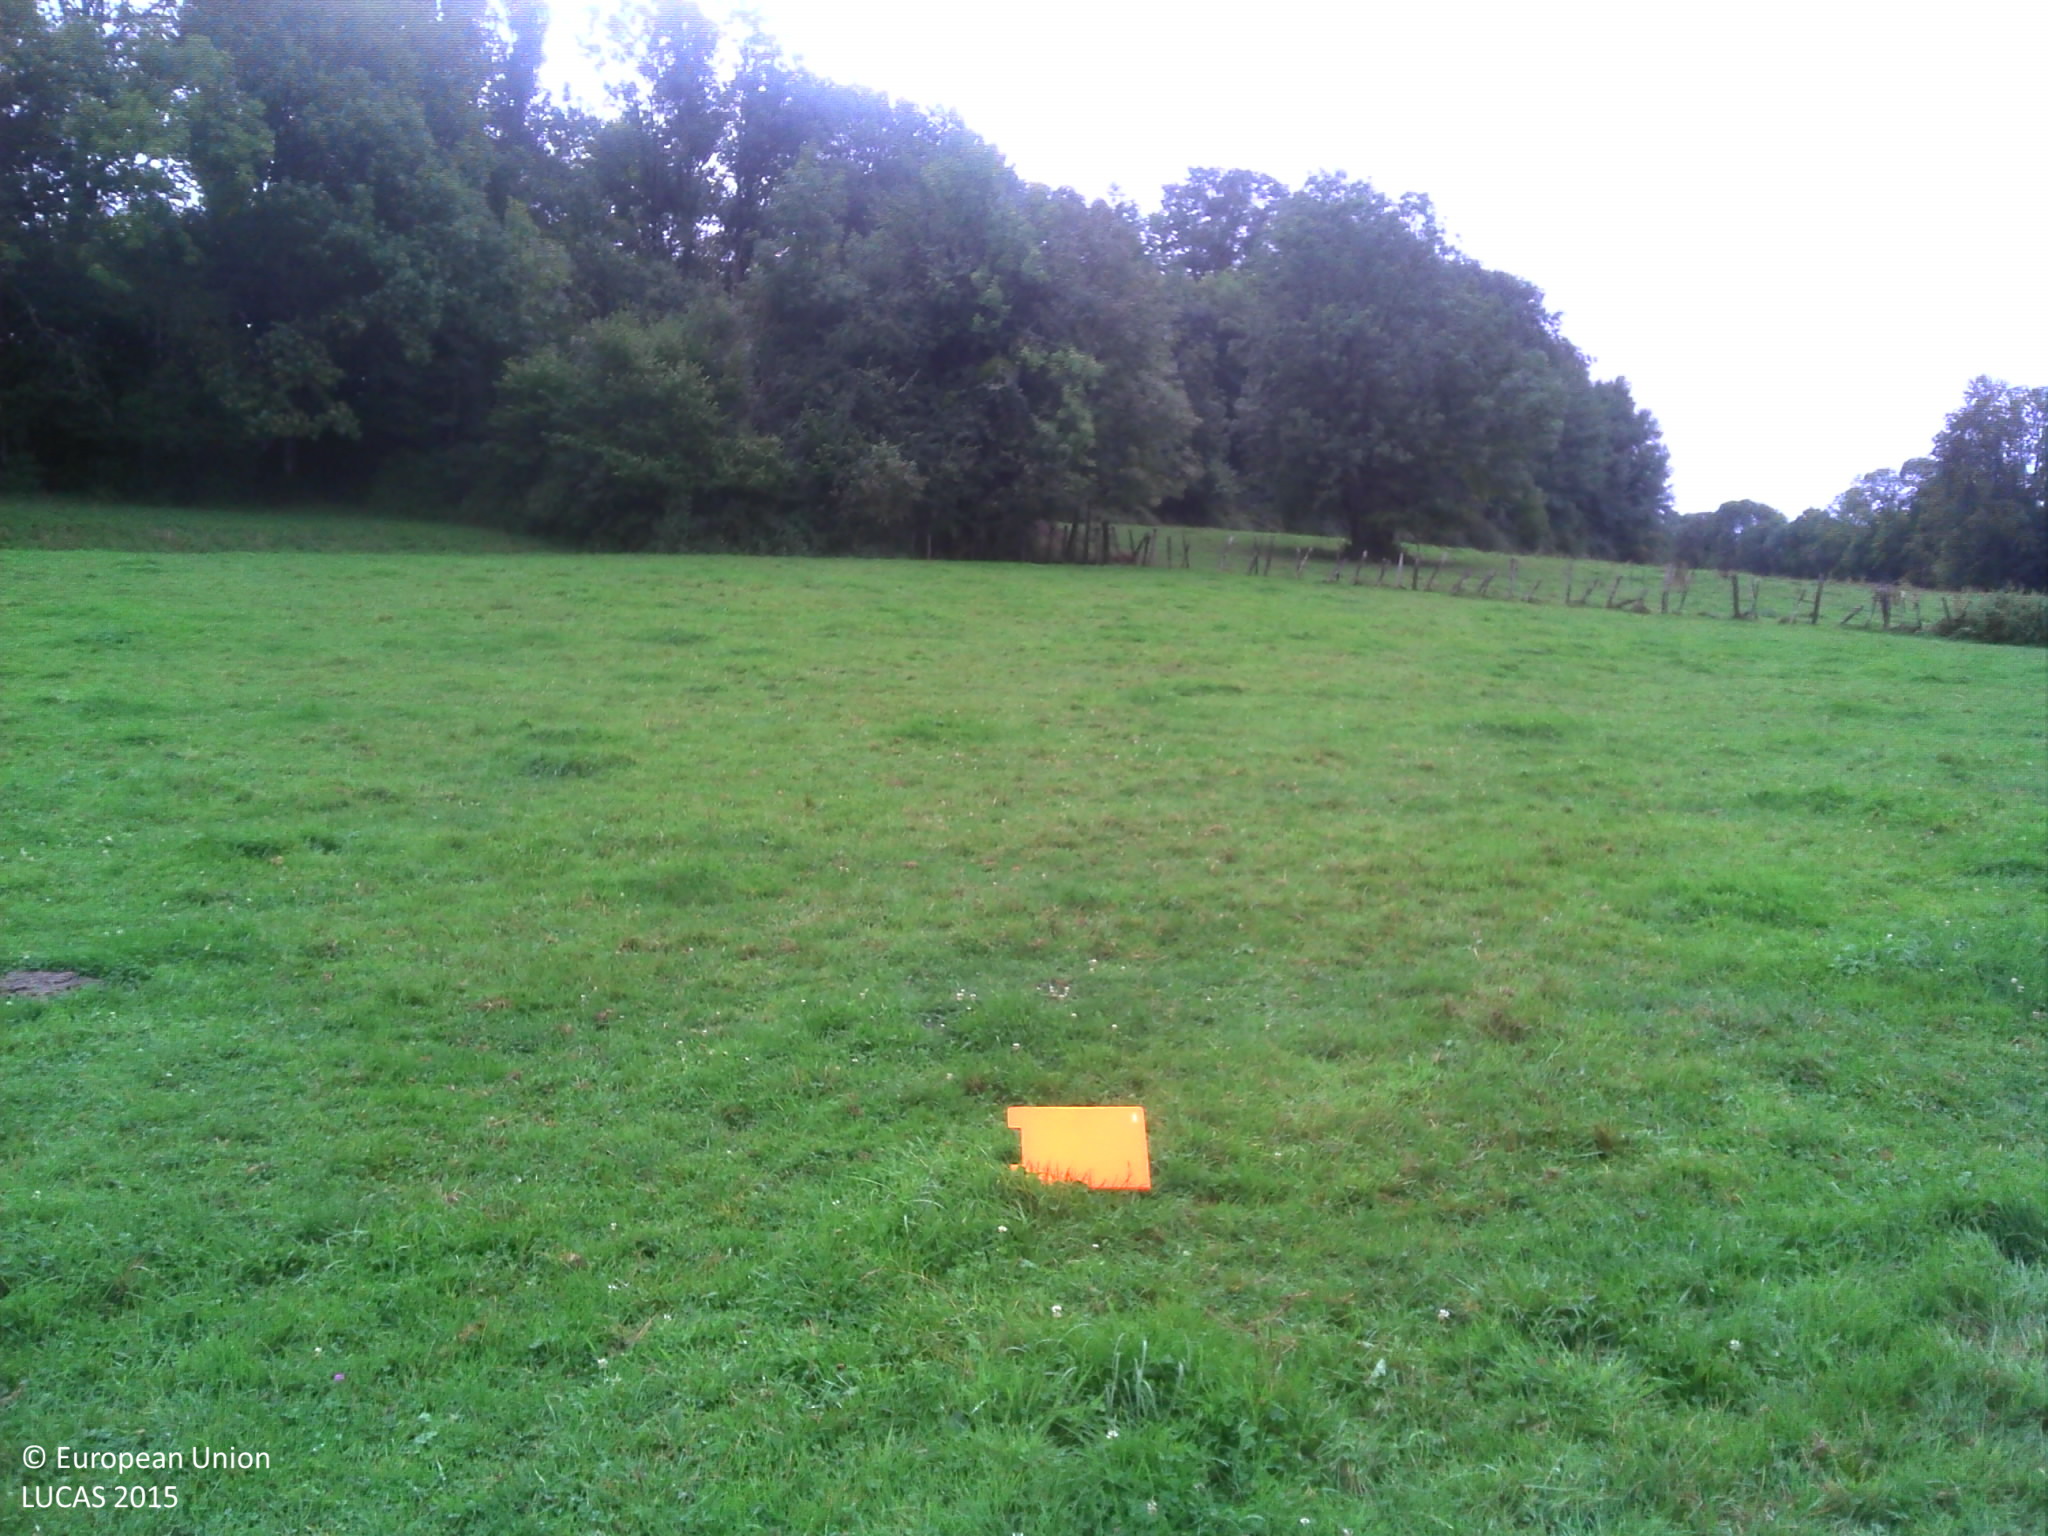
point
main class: Grassland
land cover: Grassland without tree/shrub cover
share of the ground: > 75 %
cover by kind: herbaceous plants 90 %, consolidated bare surface 10 %
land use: Agriculture (excluding fallow land and kitchen gardens)
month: September
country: FR
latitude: 47.1648
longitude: 6.1368
